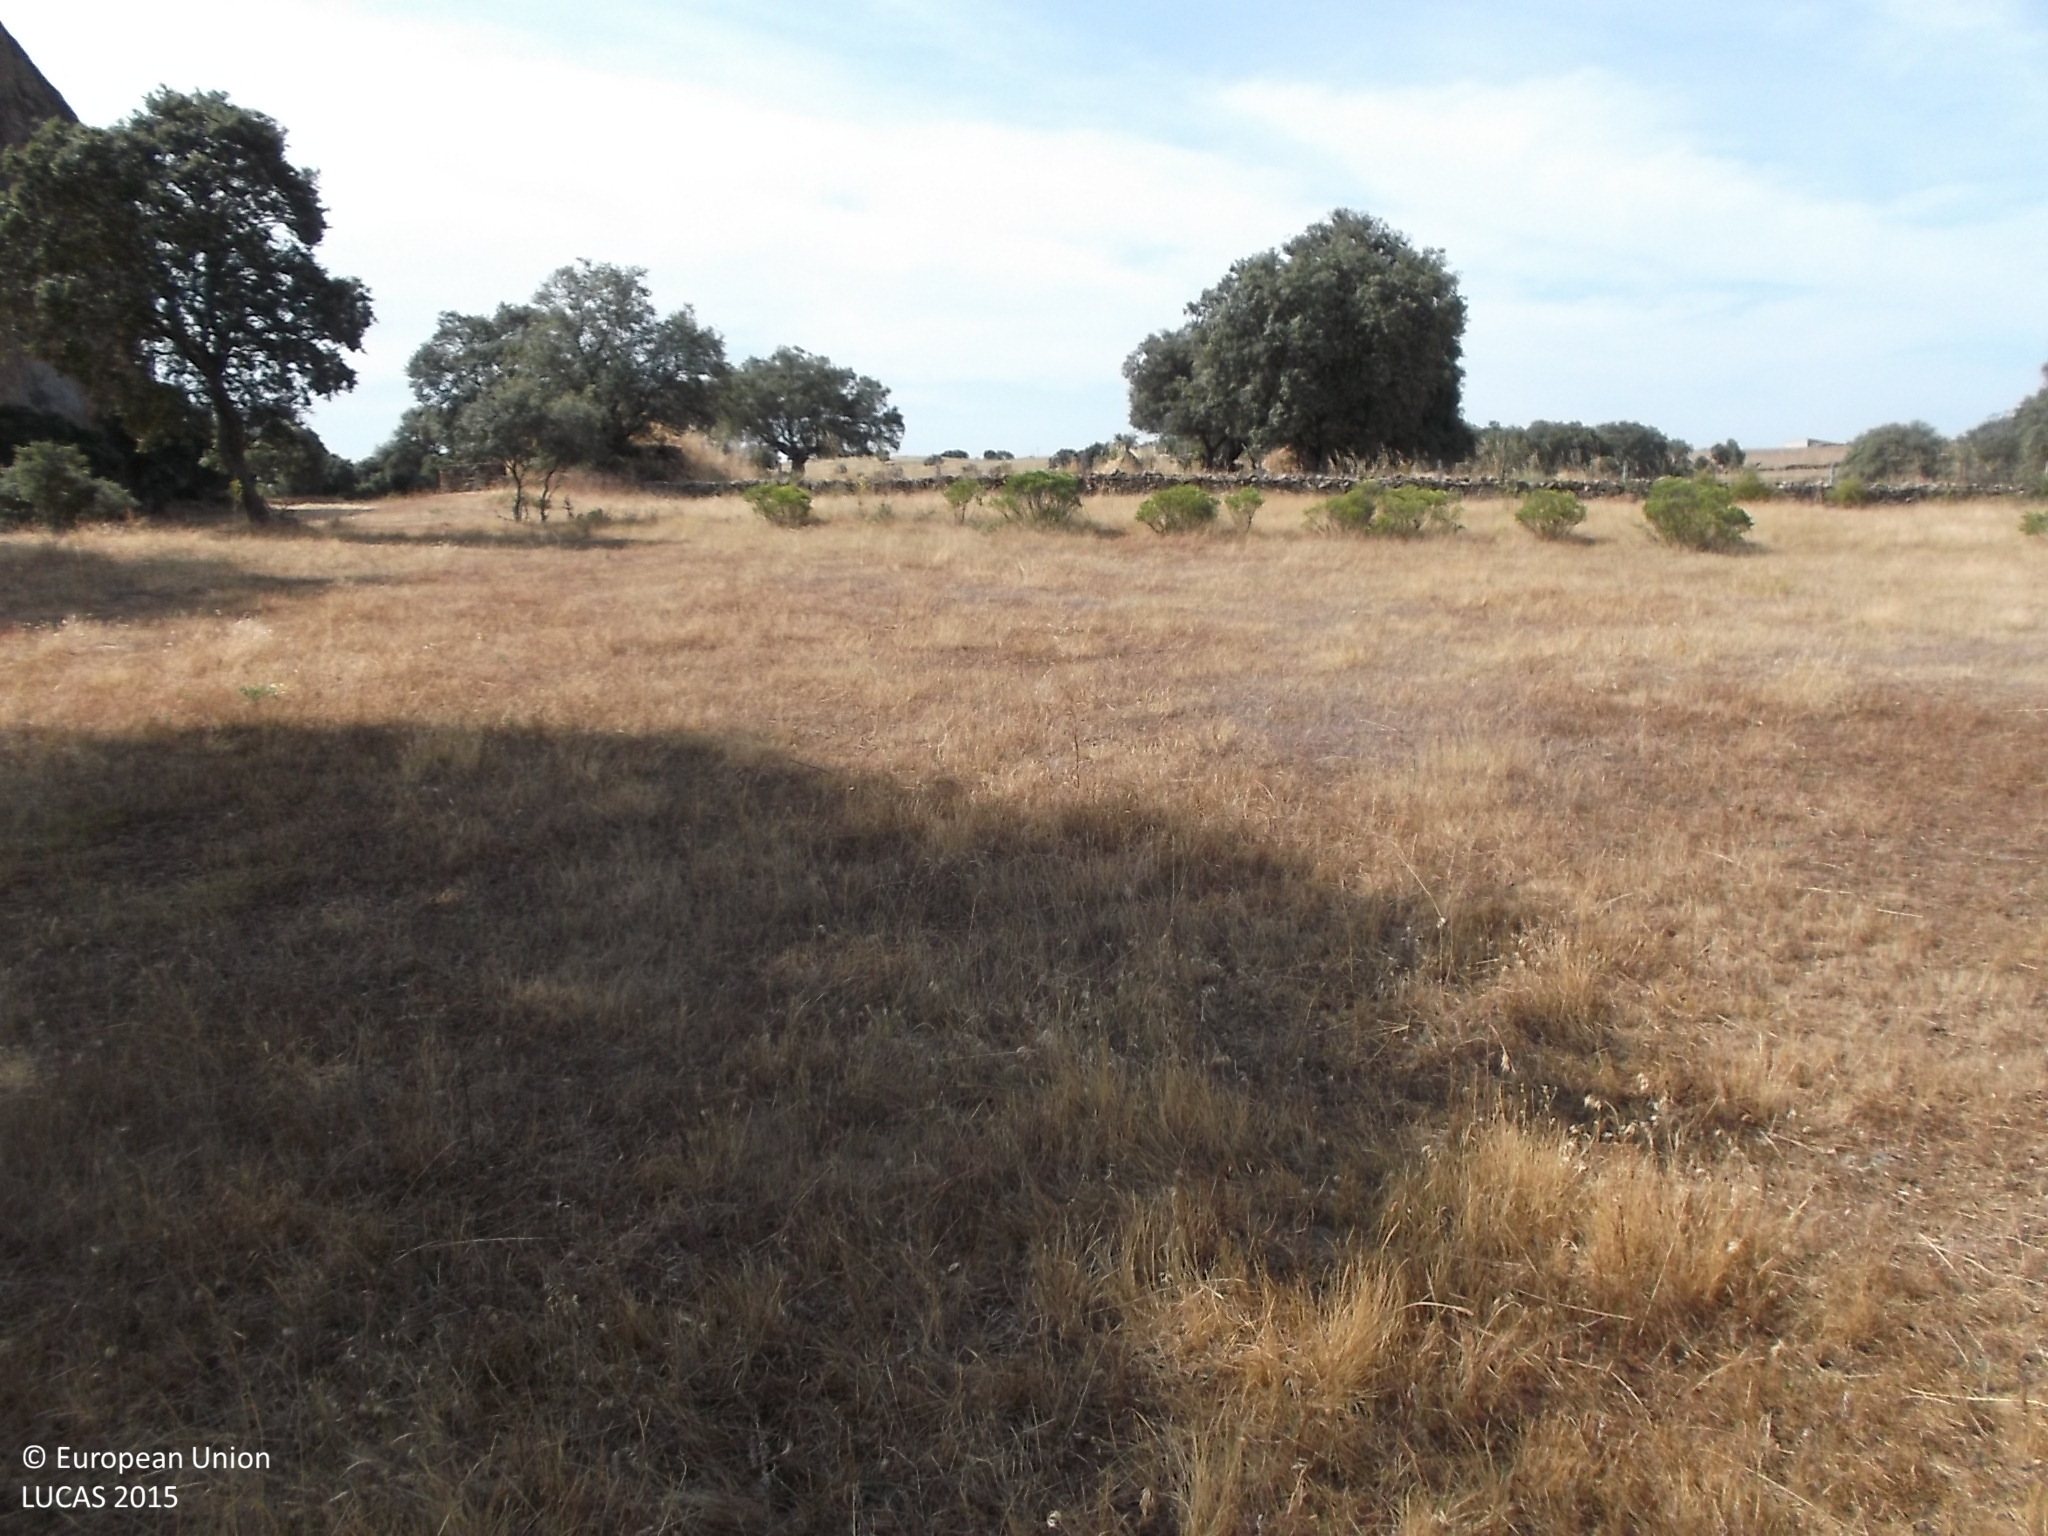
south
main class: Grassland
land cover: Grassland with sparse tree/shrub cover
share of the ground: > 75 %
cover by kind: herbaceous plants 90 %, broadleaved forest trees 5 %, shrubs 5 %
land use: Agriculture (excluding fallow land and kitchen gardens)
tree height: < 5 m
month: July
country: ES
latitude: 41.1773
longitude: -6.5127
